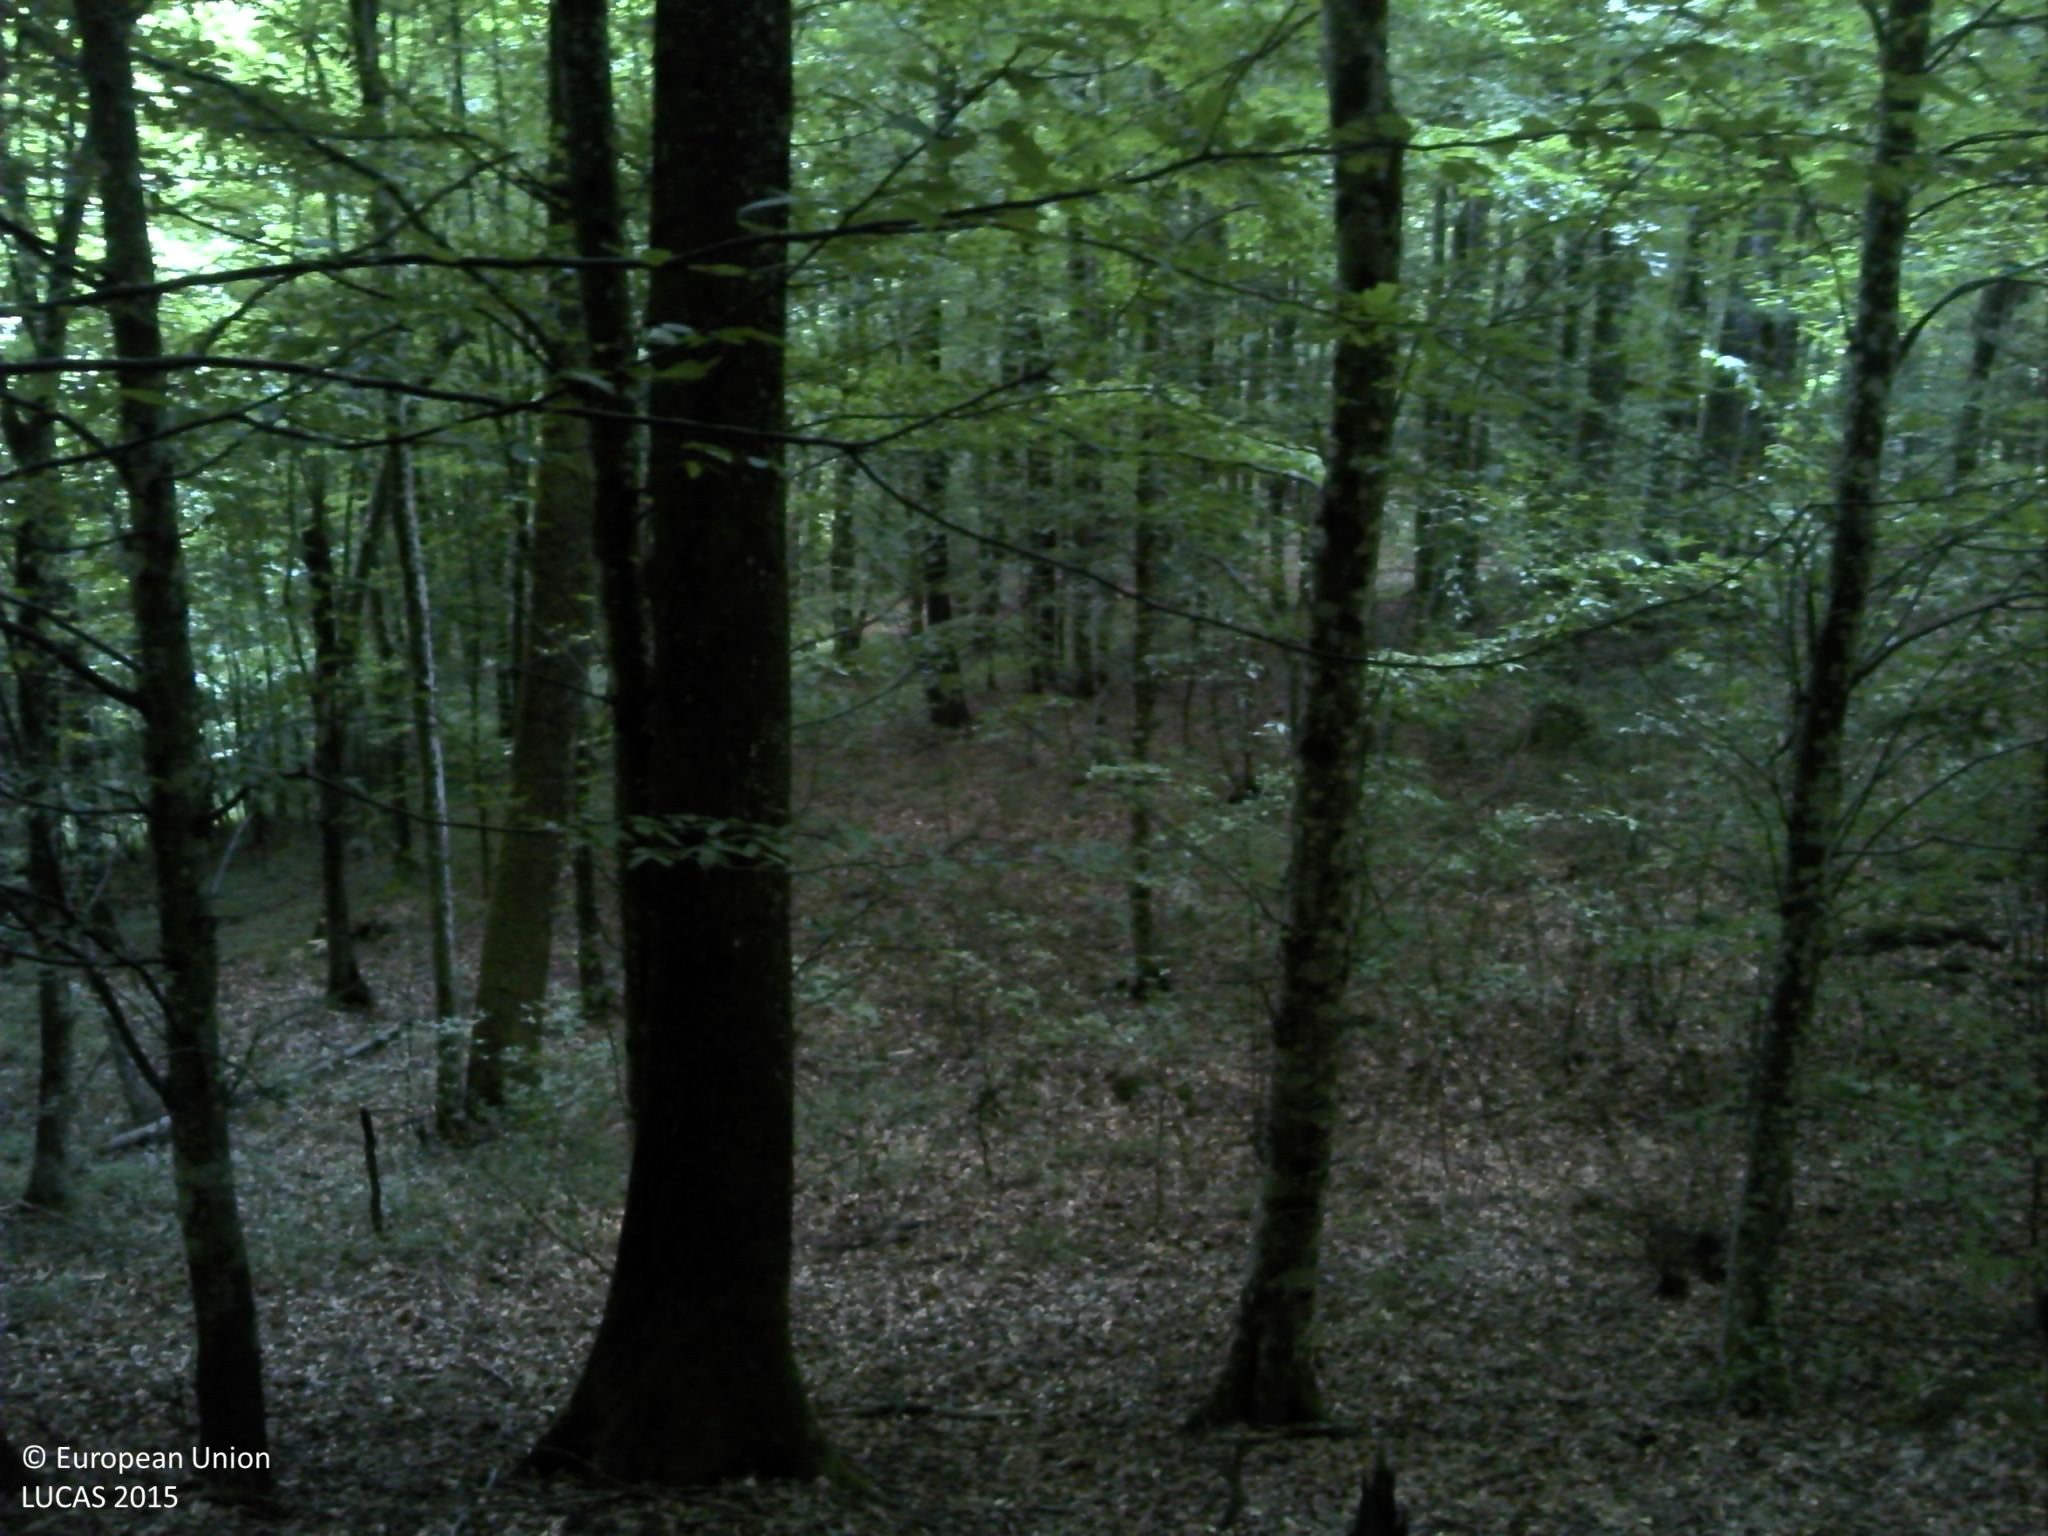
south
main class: Woodland
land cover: Broadleaved woodland
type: beech forest
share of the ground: > 75 %
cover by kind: broadleaved forest trees 80 %, lichens and mosses 20 %
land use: Forestry
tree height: > 5 m
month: June
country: HR
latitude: 45.4001
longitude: 17.2436
